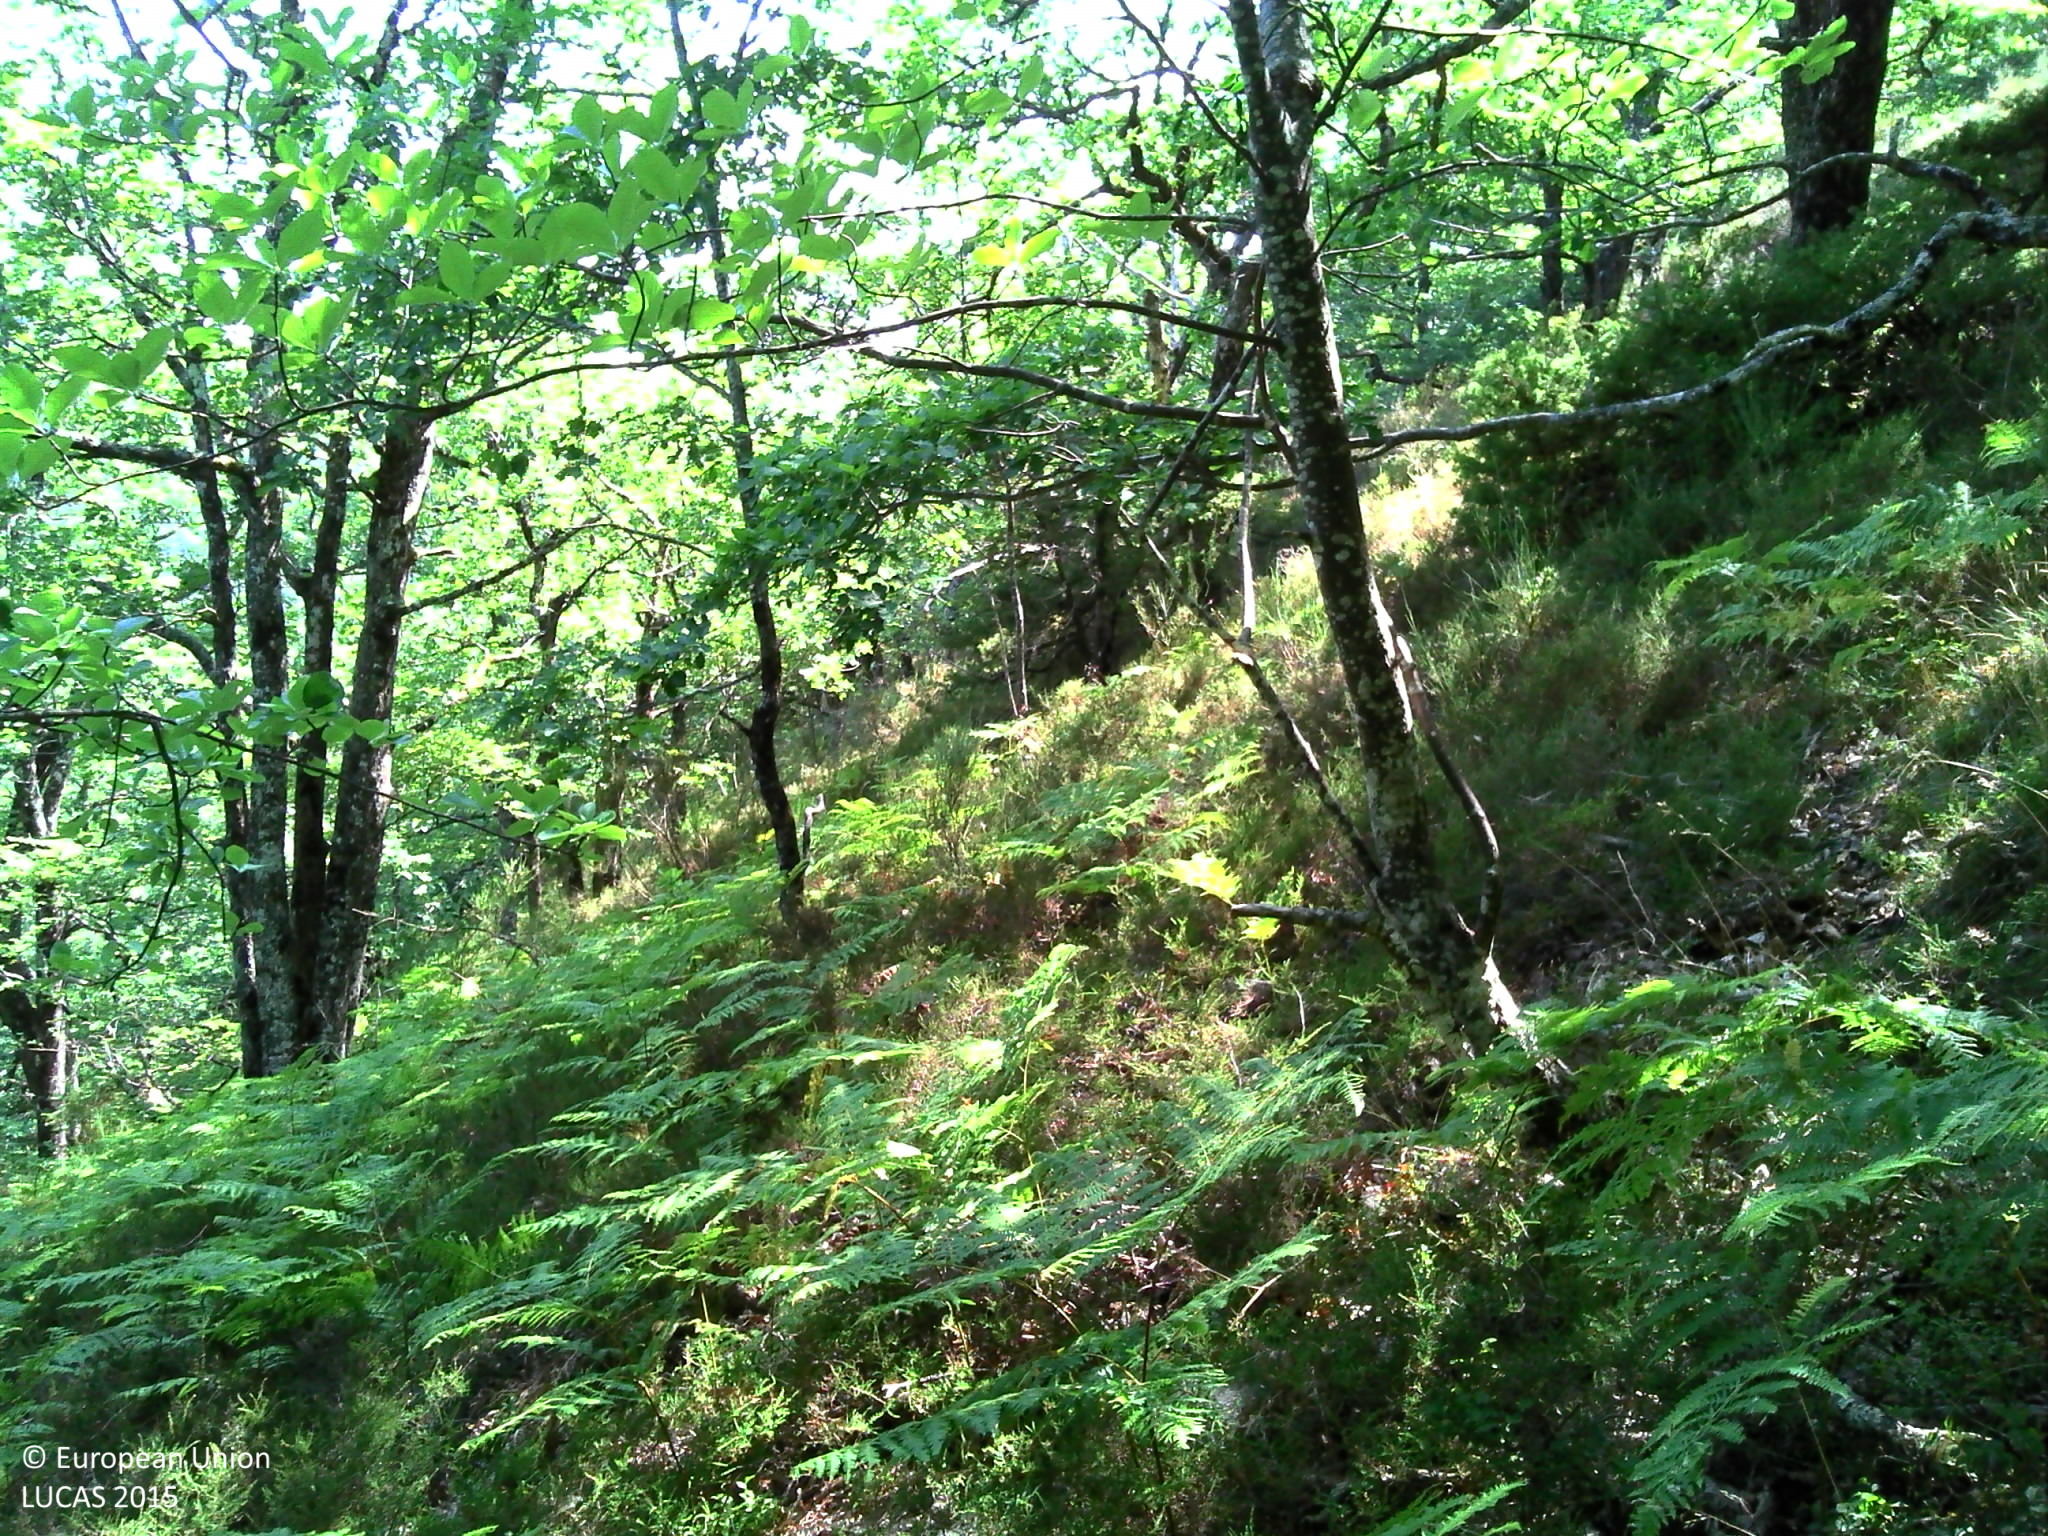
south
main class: Woodland
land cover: Broadleaved woodland
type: acidophilous oak and oak-birch forest
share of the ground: > 75 %
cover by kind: broadleaved forest trees 90 %, shrubs 5 %, herbaceous plants 5 %
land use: Semi-natural and natural areas not in use
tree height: > 5 m
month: July
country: FR
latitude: 44.5299
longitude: 2.9950
